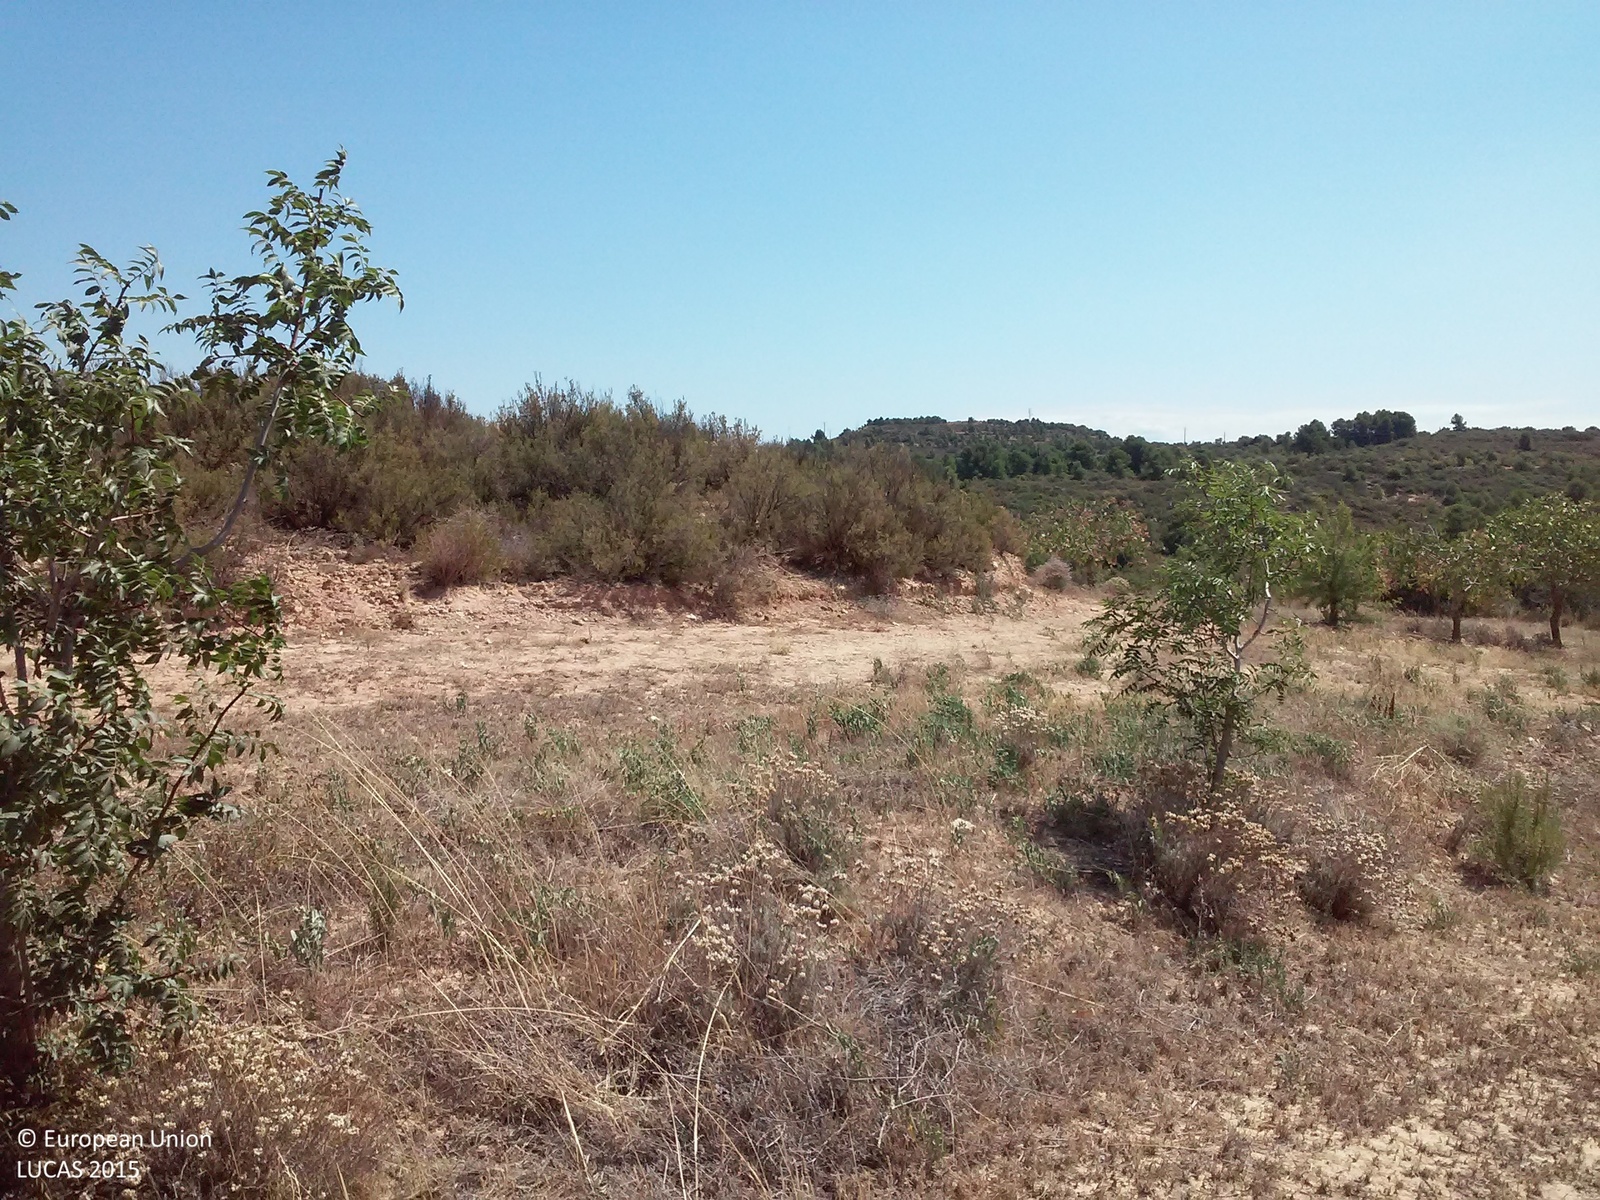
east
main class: Cropland
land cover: Nuts trees
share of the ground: > 75 %
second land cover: Other bare soil
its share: > 75 %
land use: Agriculture (excluding fallow land and kitchen gardens)
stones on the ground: 25 - 50 %
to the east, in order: Nuts trees; Other bare soil; Shrubland with sparse tree cover; Nuts trees; Shrubland with sparse tree cover; Nuts trees; Shrubland with sparse tree cover; Nuts trees; Shrubland with sparse tree cover; Tracks; Barley; Shrubland with sparse tree cover
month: August
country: ES
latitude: 41.3734
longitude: 0.5318
